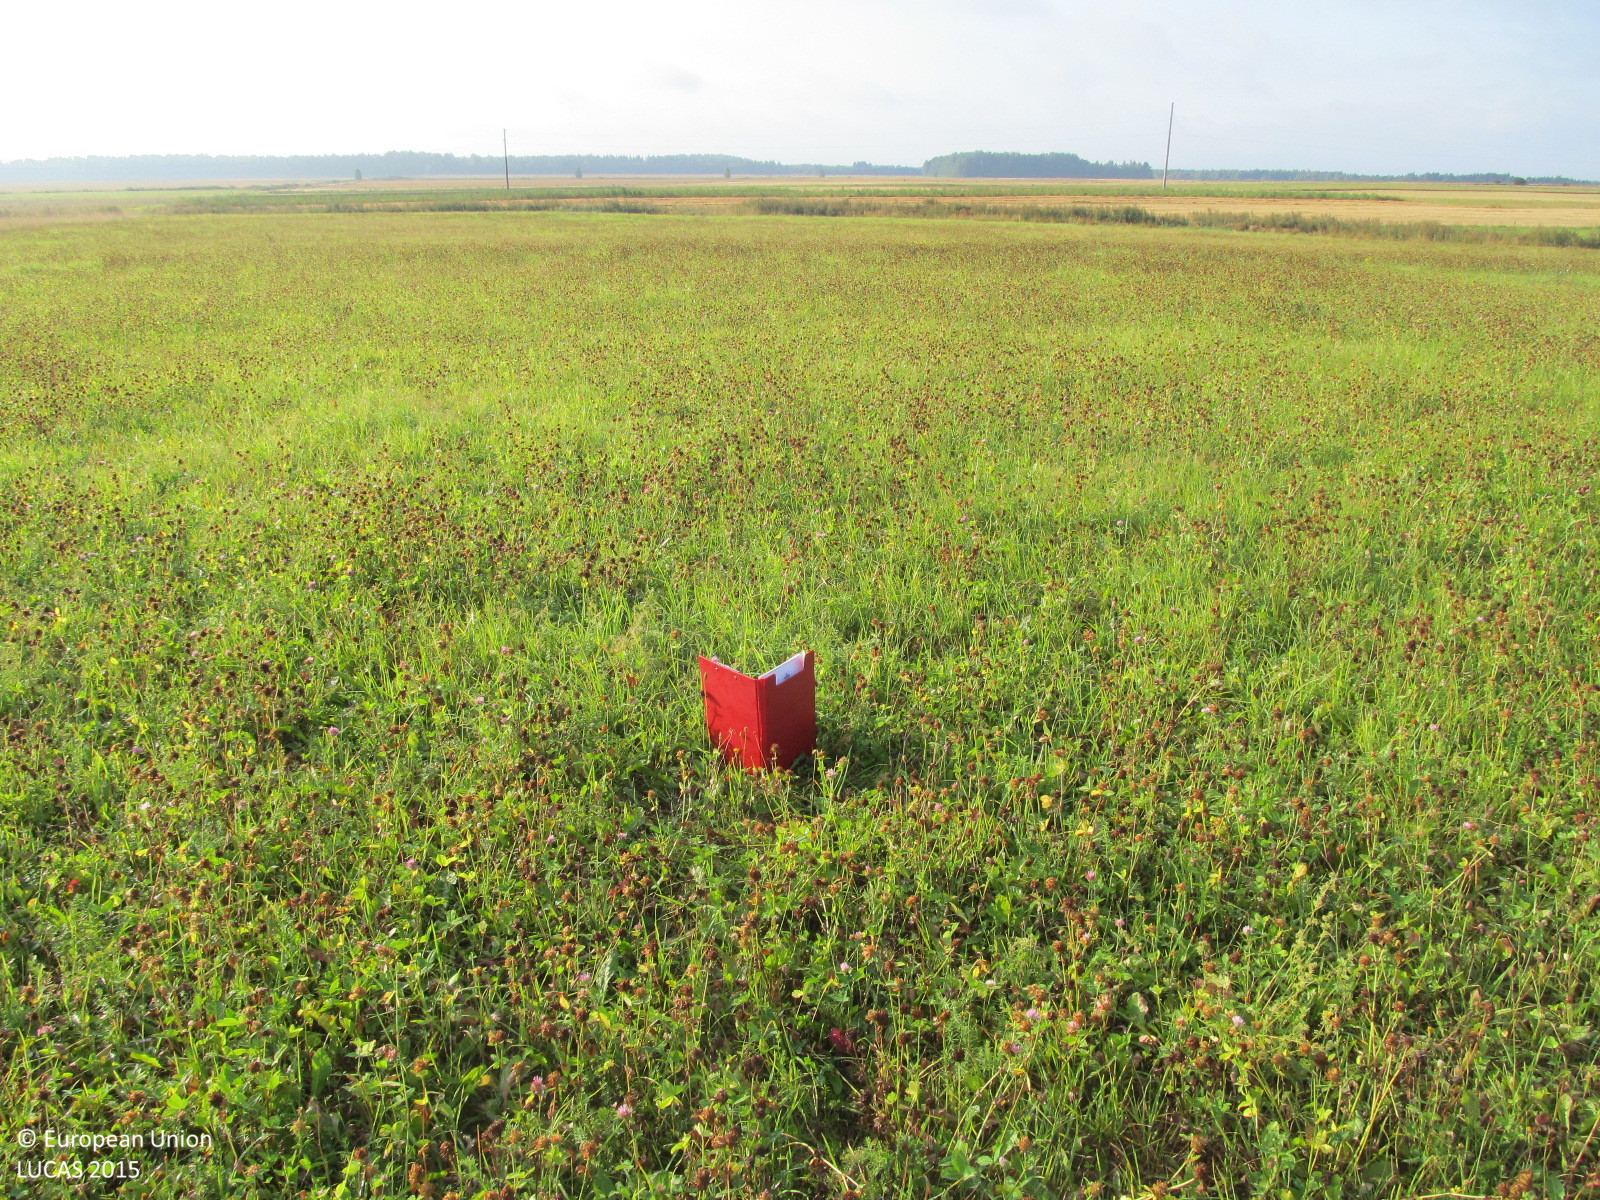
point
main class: Cropland
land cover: Clovers
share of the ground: > 75 %
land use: Agriculture (excluding fallow land and kitchen gardens)
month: August
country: LT
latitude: 55.6574
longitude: 23.2824
